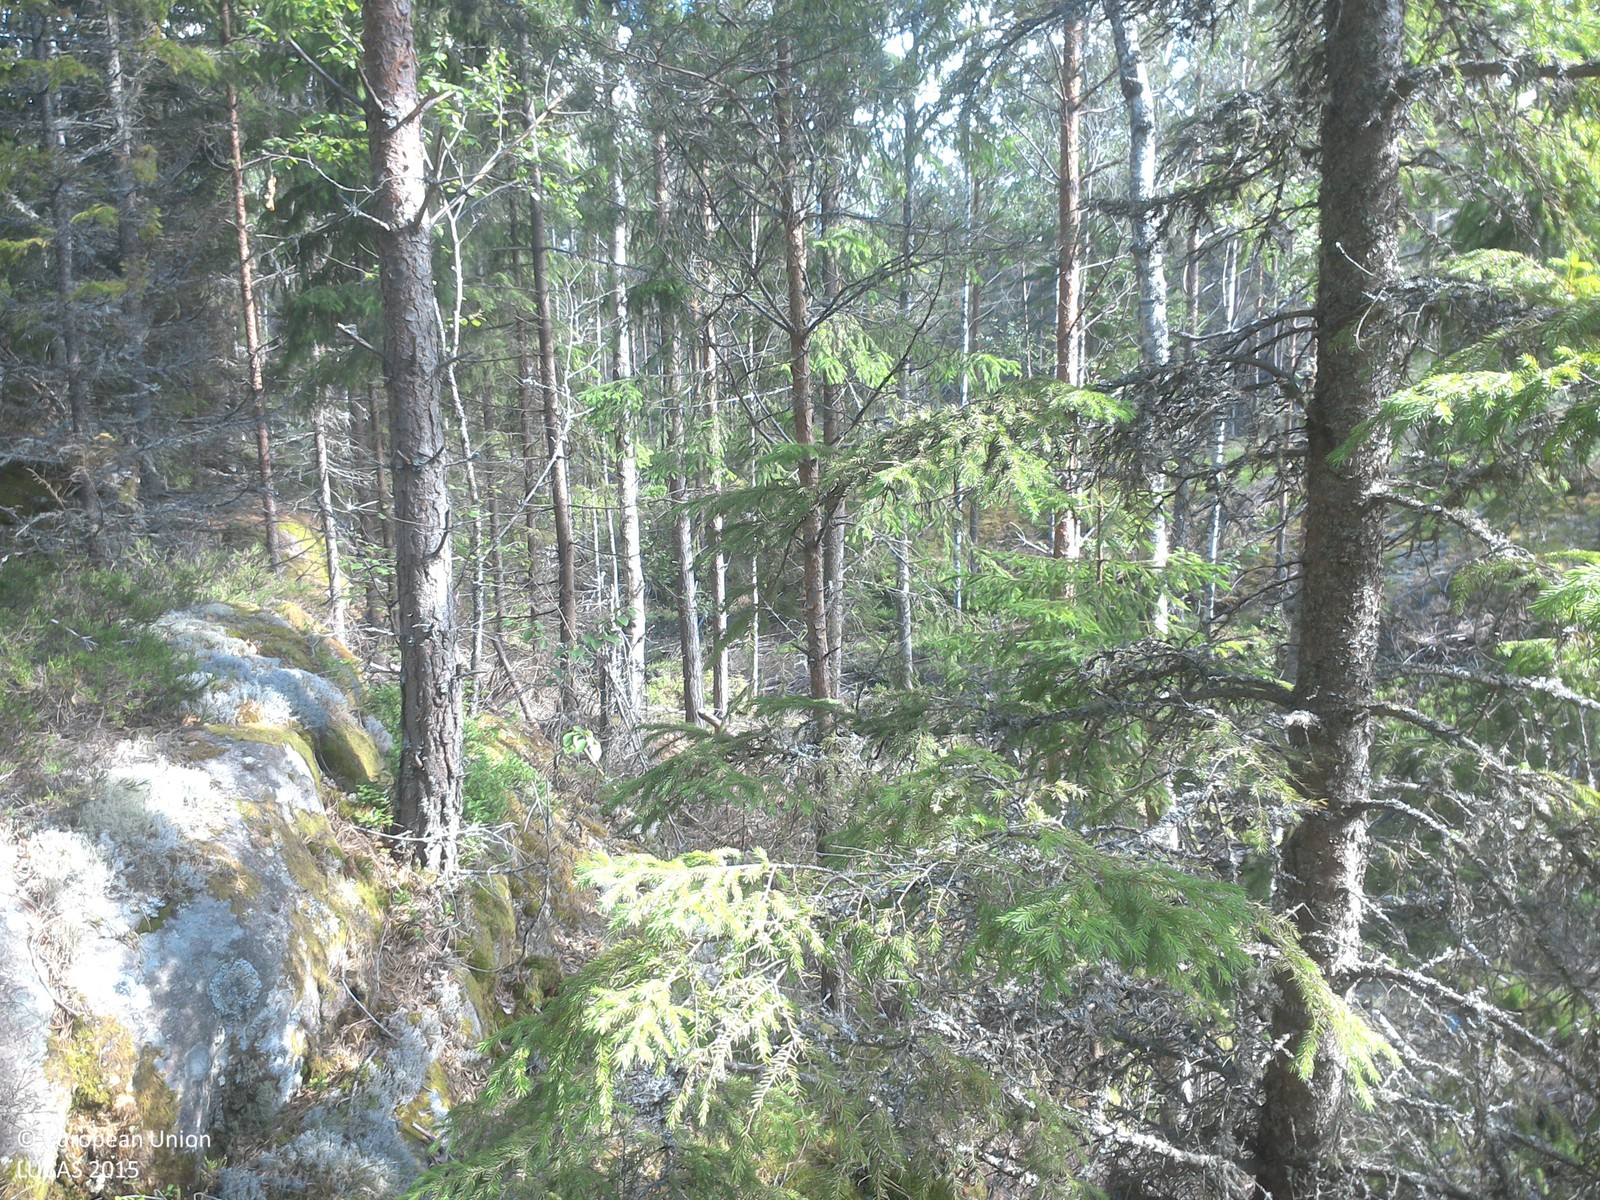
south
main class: Woodland
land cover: Pine dominated mixed woodland
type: boreal forest
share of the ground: > 75 %
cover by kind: coniferous forest trees 60 %, broadleaved forest trees 20 %, herbaceous plants 10 %, lichens and mosses 10 %
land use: Forestry
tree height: > 5 m
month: June
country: SE
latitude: 58.0264
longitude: 15.7018
